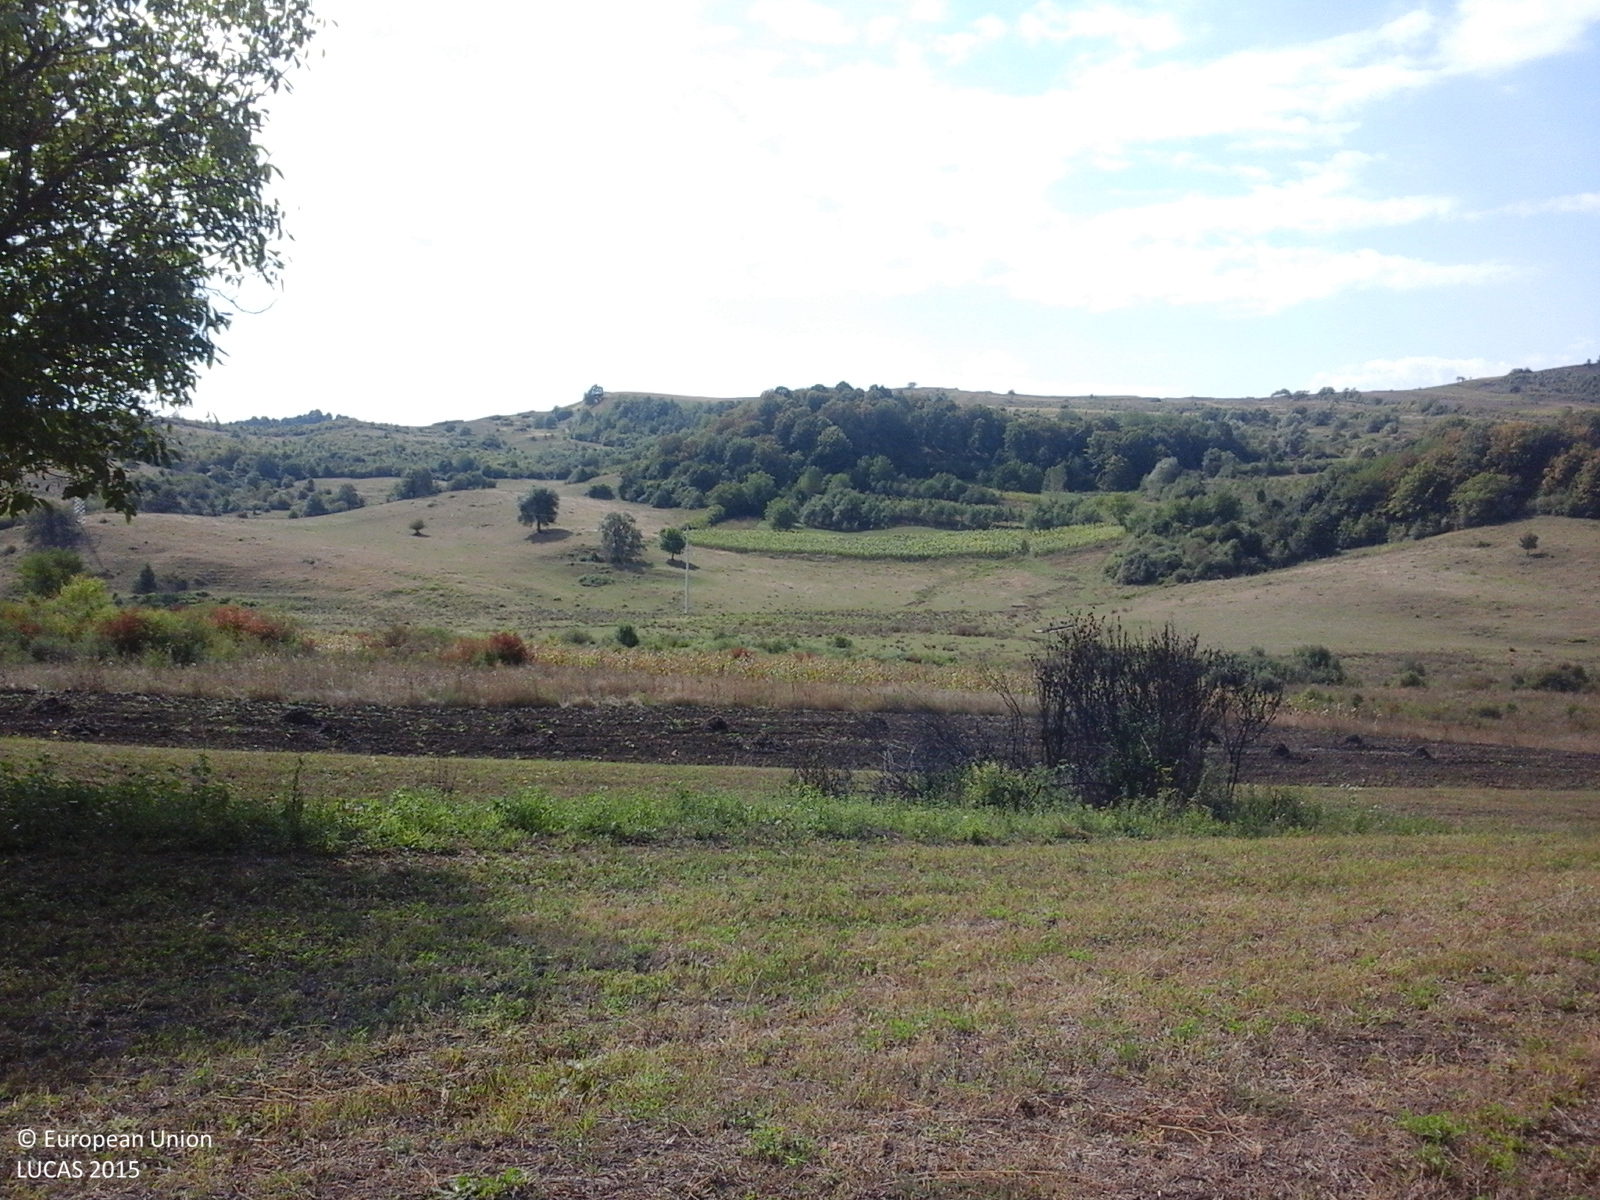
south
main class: Cropland
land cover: Lucerne
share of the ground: > 75 %
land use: Agriculture (excluding fallow land and kitchen gardens)
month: September
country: RO
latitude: 47.3510
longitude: 23.2131
